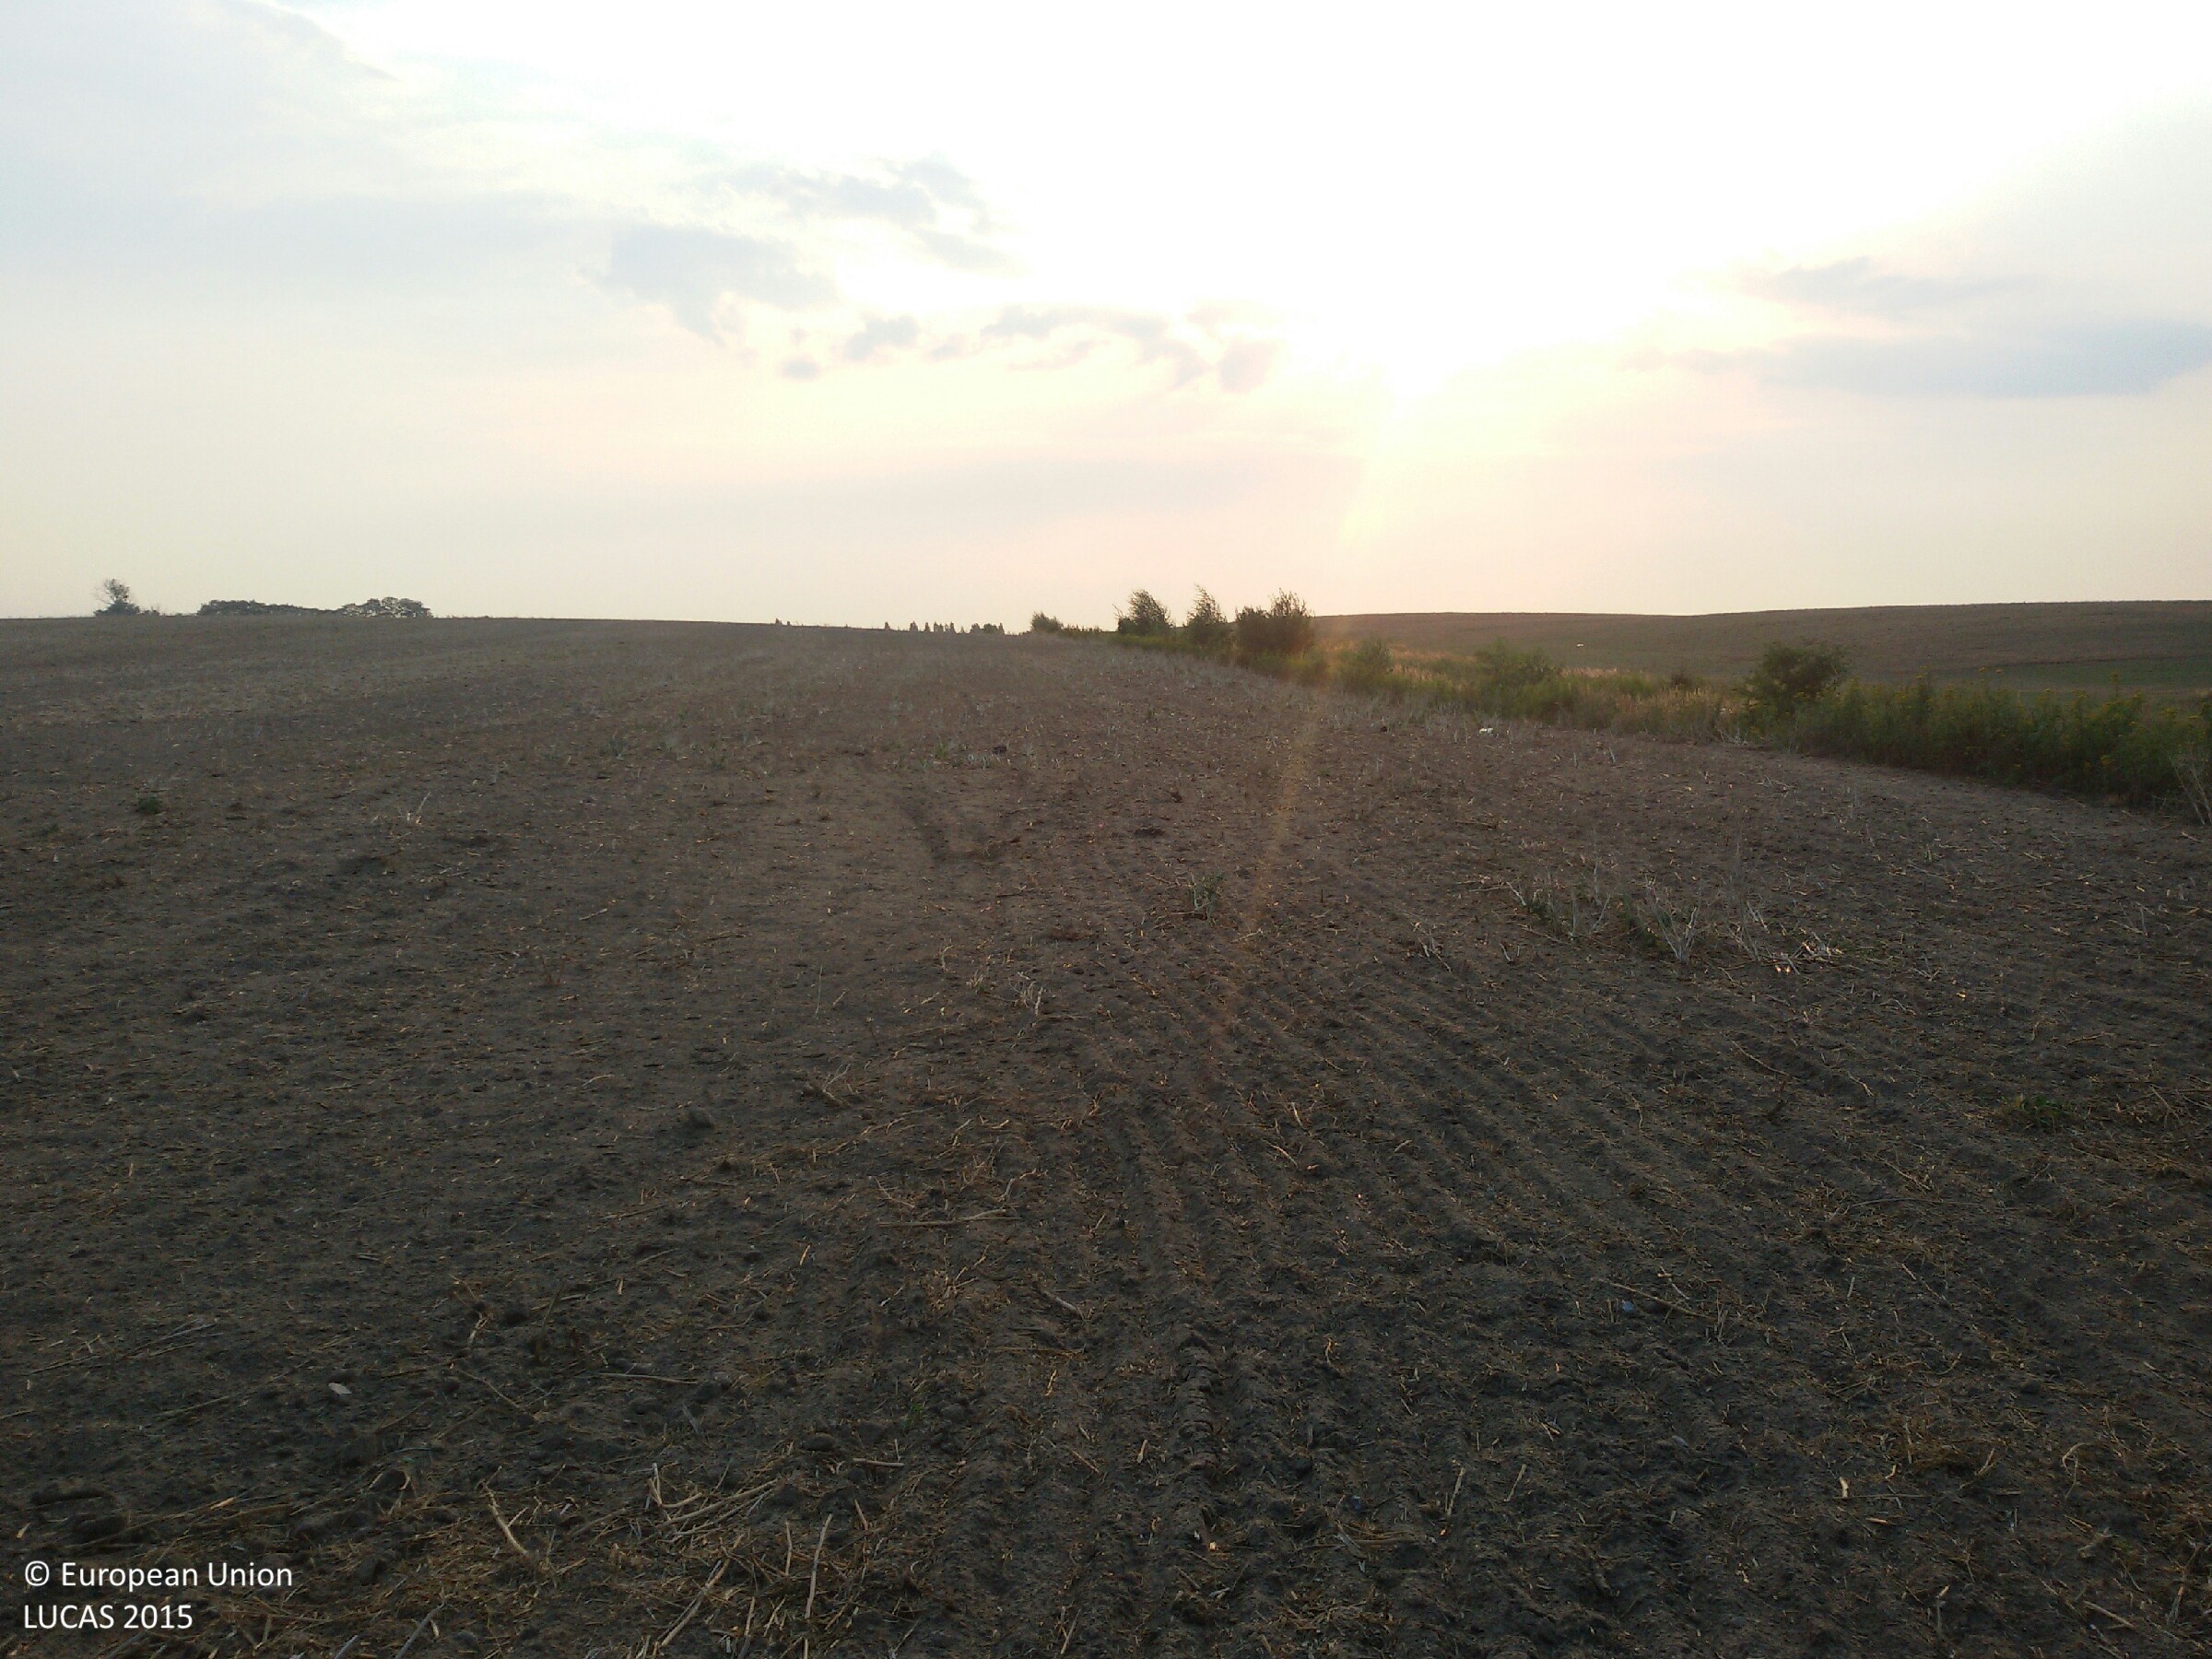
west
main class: Cropland
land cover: Rape and turnip rape
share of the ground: < 10 %
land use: Agriculture (excluding fallow land and kitchen gardens)
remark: Harvested field
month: August
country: PL
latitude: 52.9242
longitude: 14.4488
